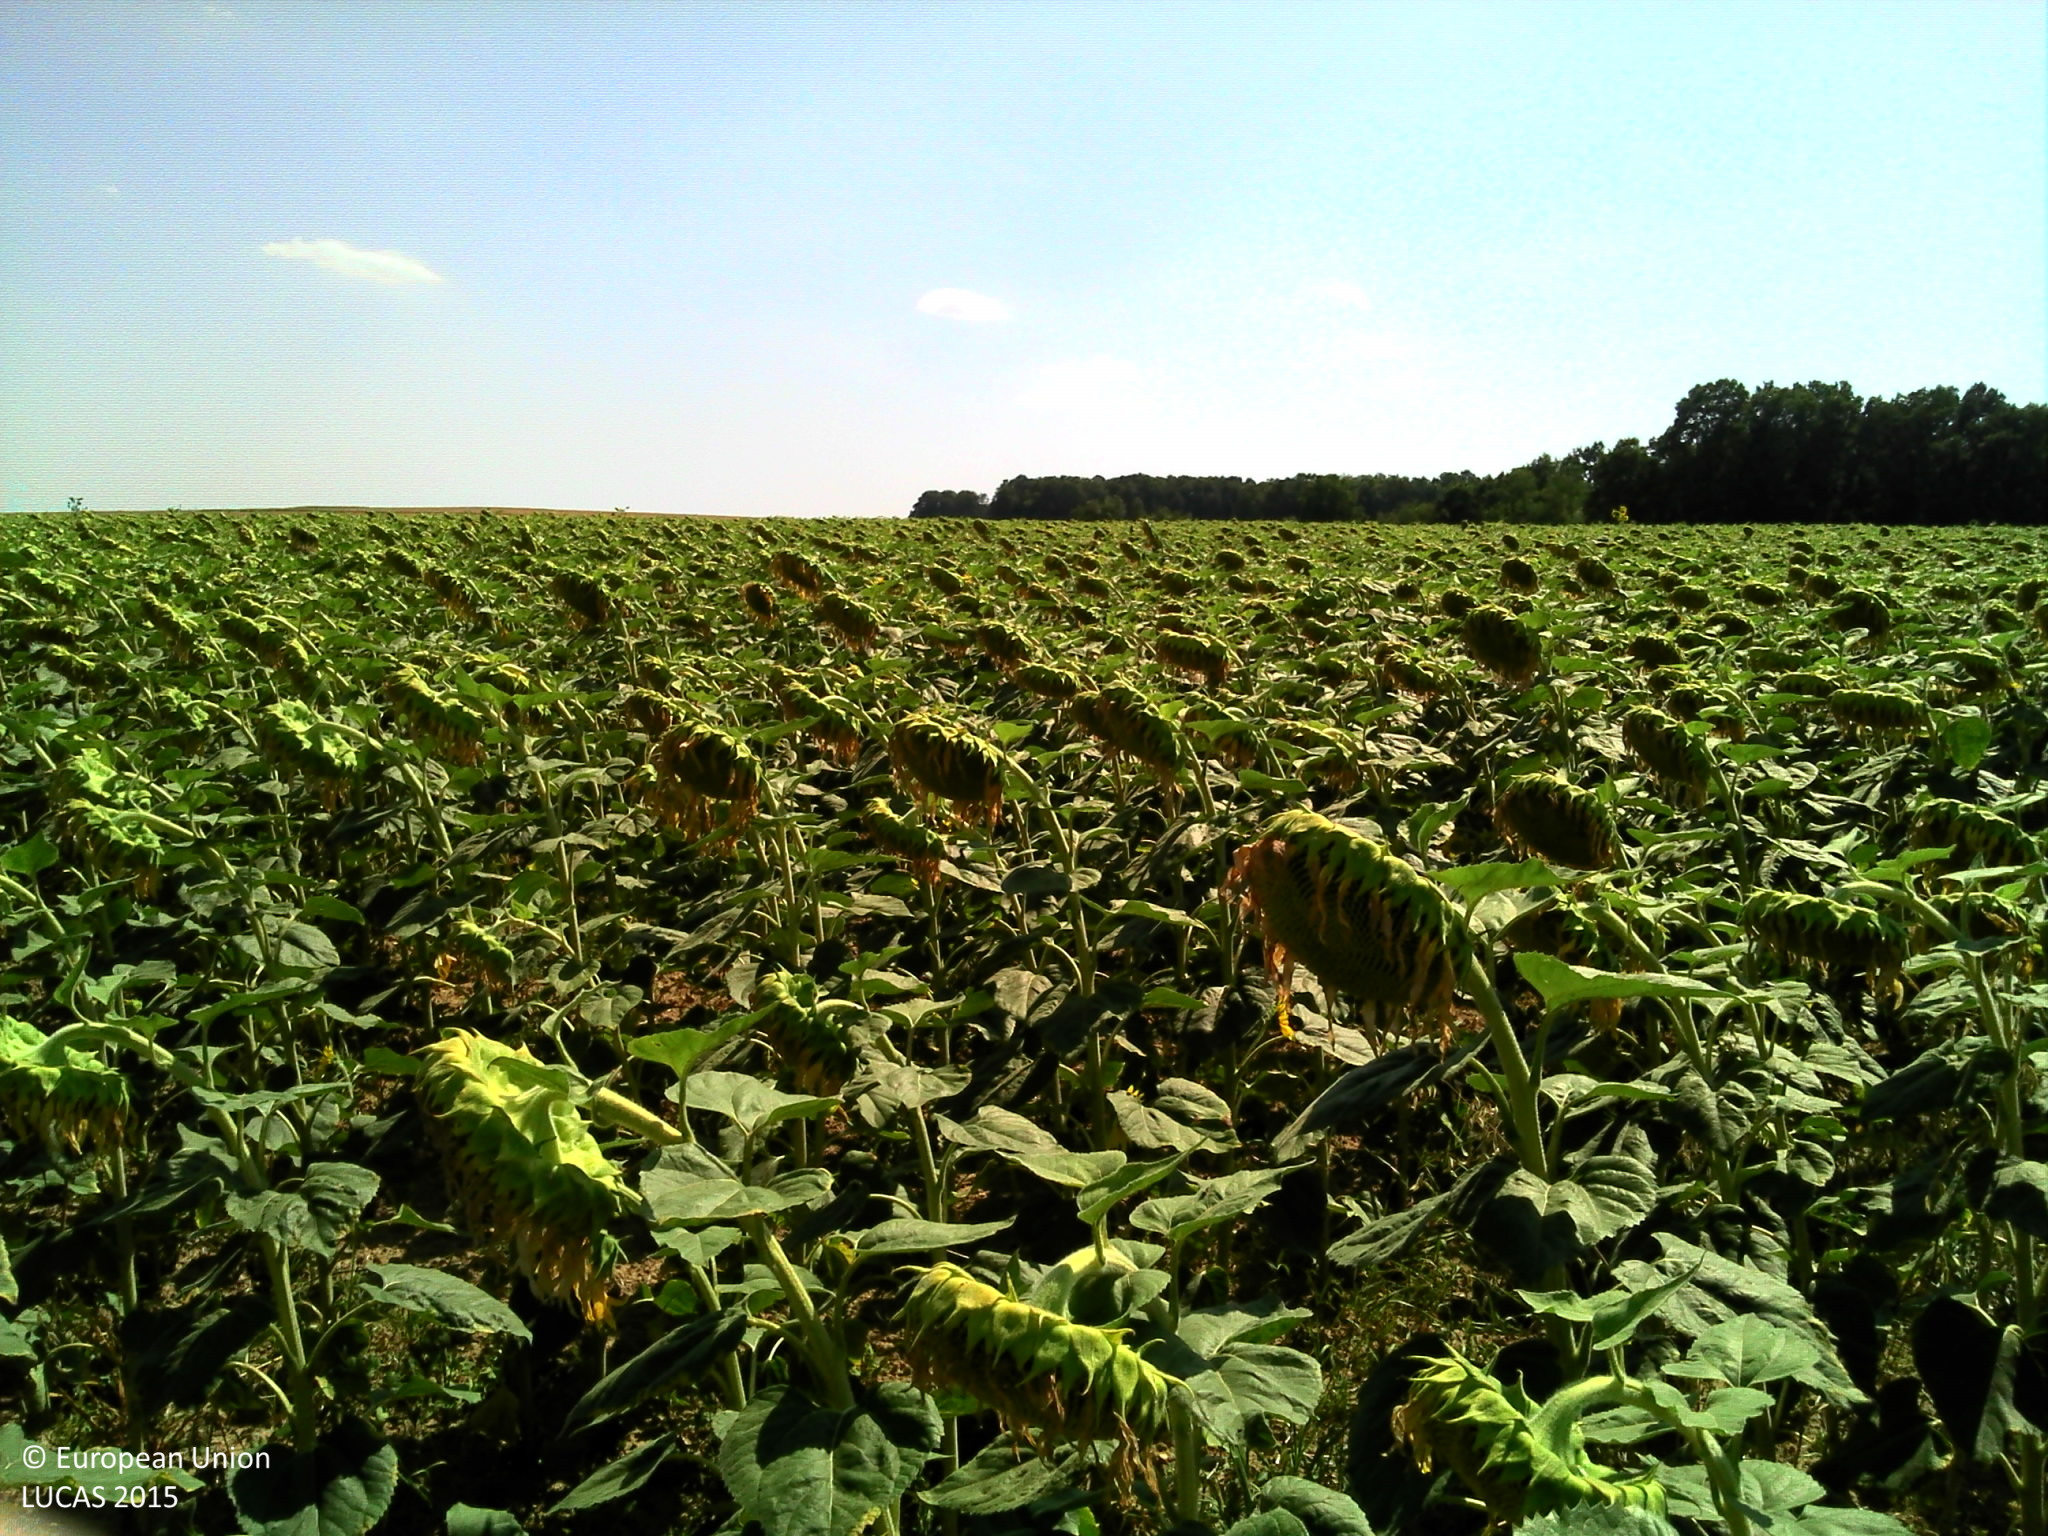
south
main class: Cropland
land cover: Sunflower
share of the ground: > 75 %
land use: Agriculture (excluding fallow land and kitchen gardens)
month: August
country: FR
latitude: 47.8830
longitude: 3.4291
